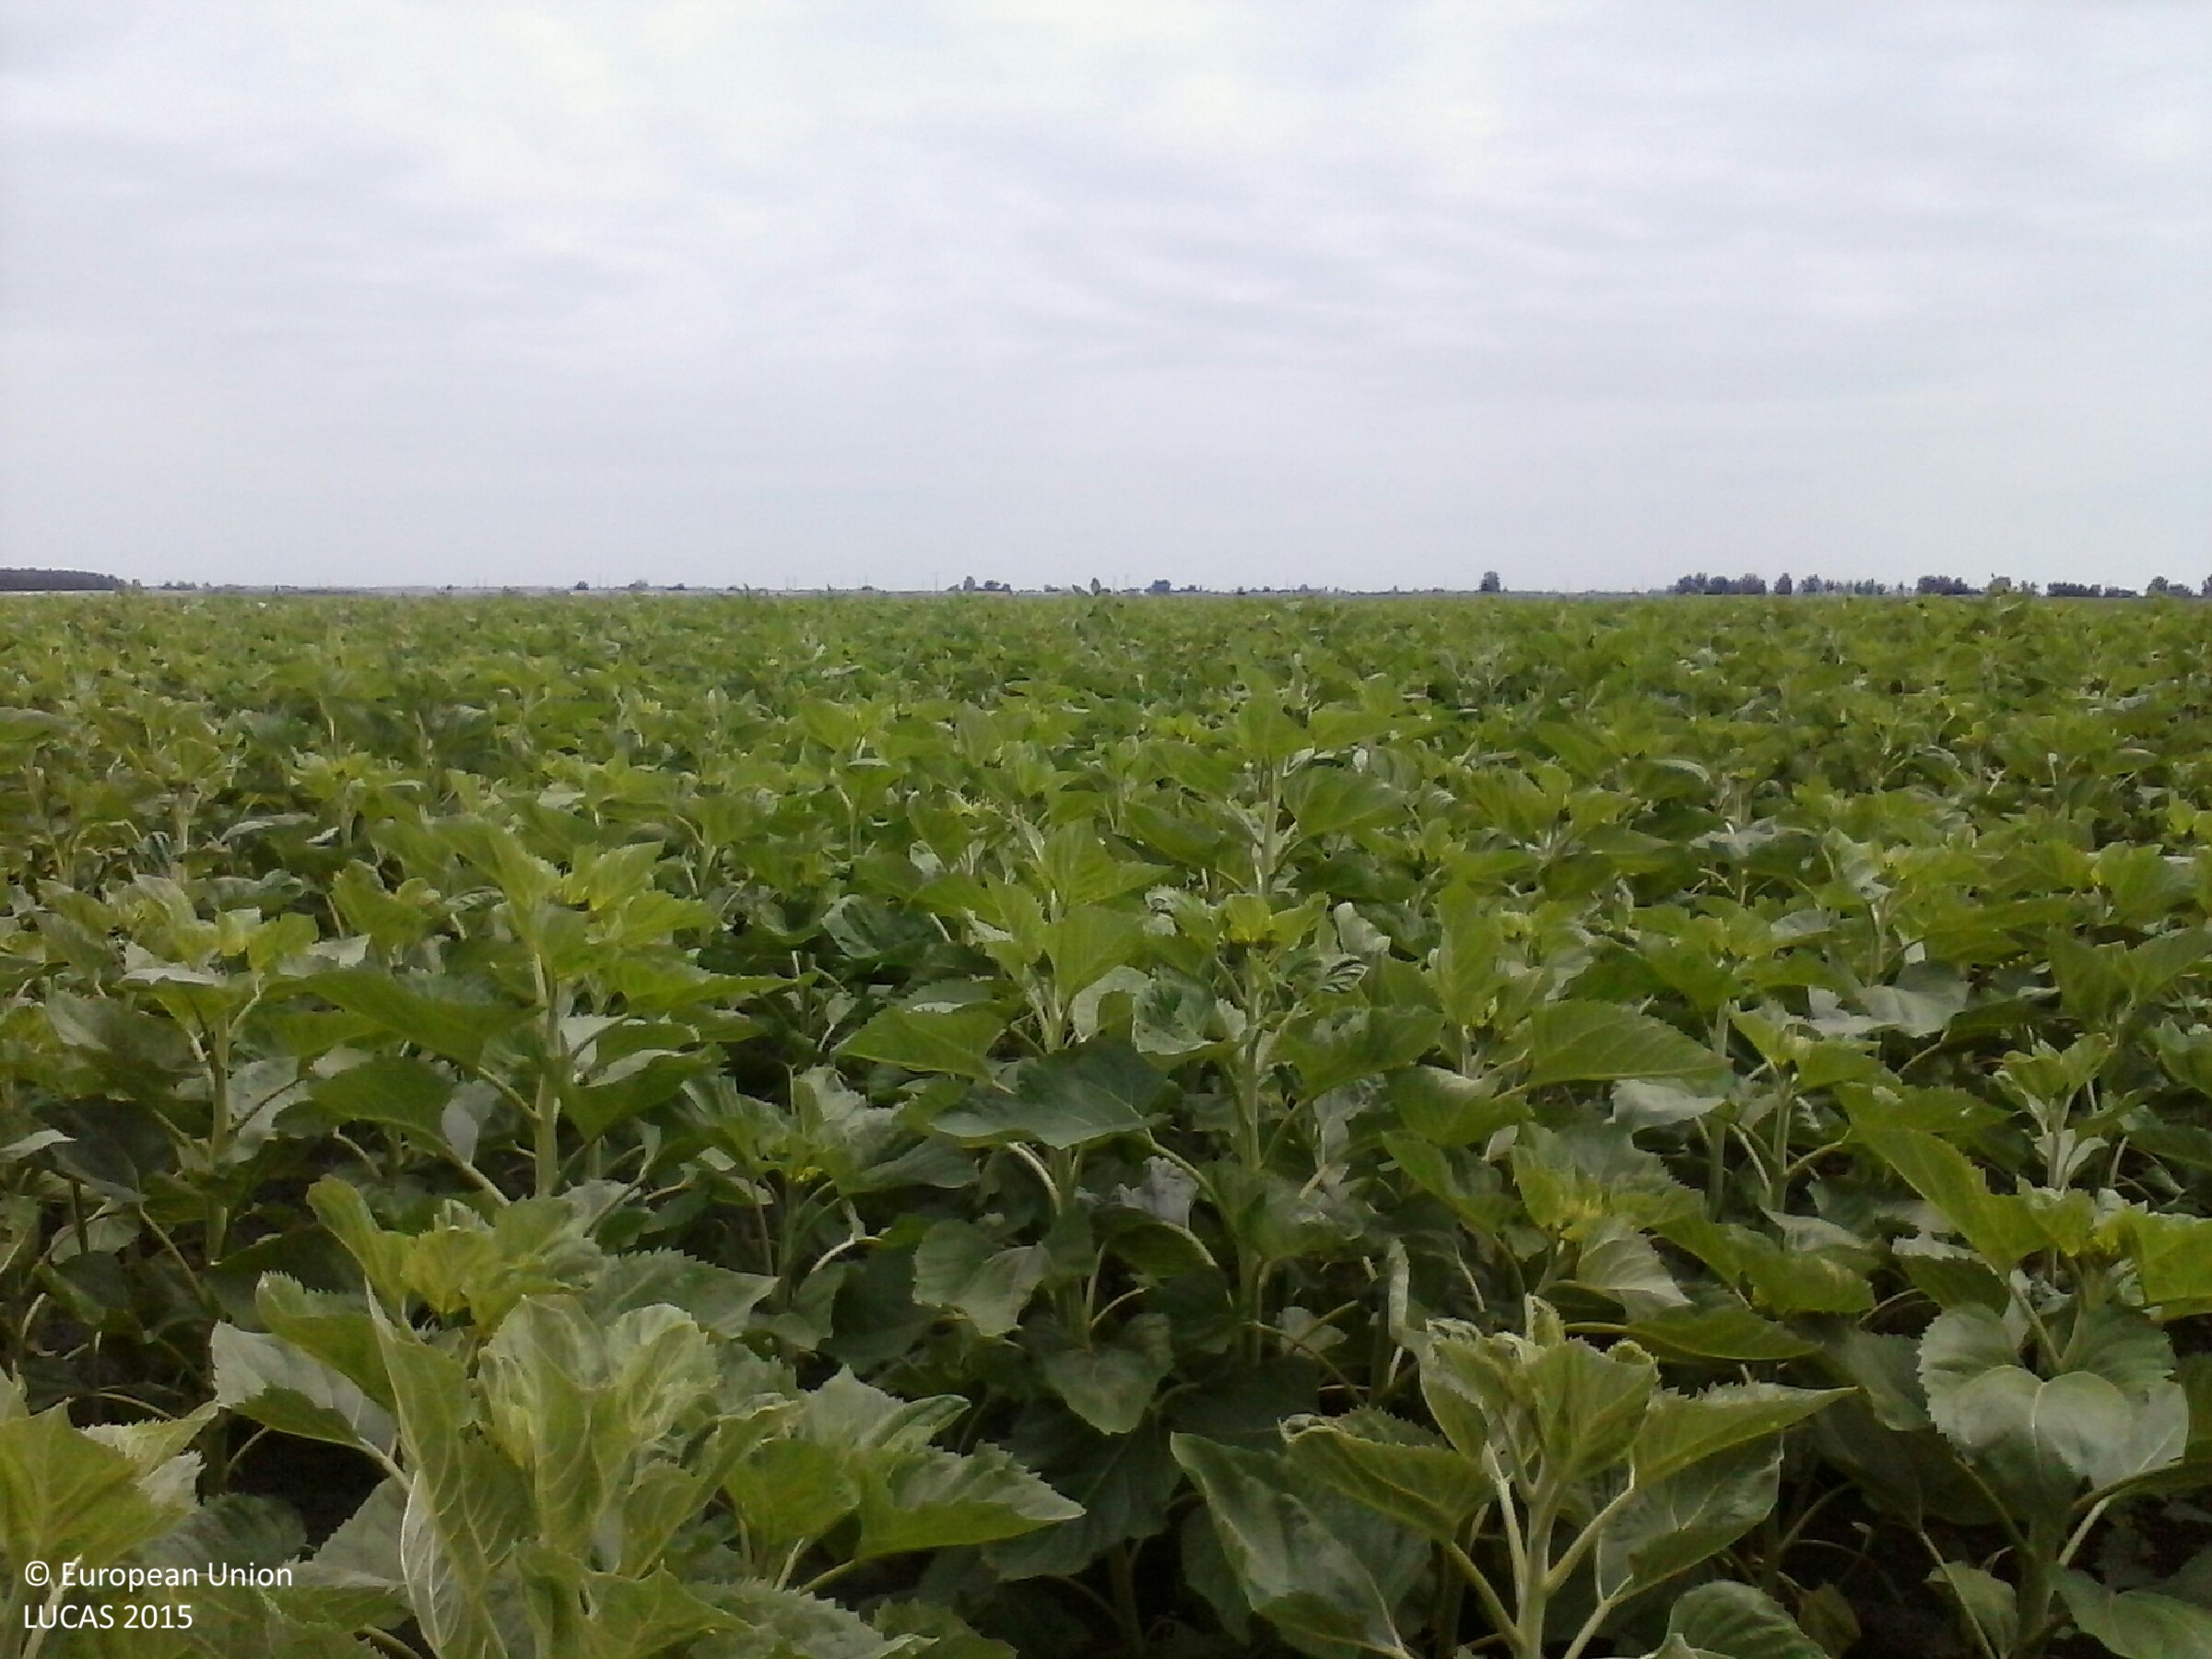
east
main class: Cropland
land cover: Sunflower
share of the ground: > 75 %
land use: Agriculture (excluding fallow land and kitchen gardens)
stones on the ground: < 10 %
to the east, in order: Sunflower
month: June
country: HU
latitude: 46.1798
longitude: 20.2959
